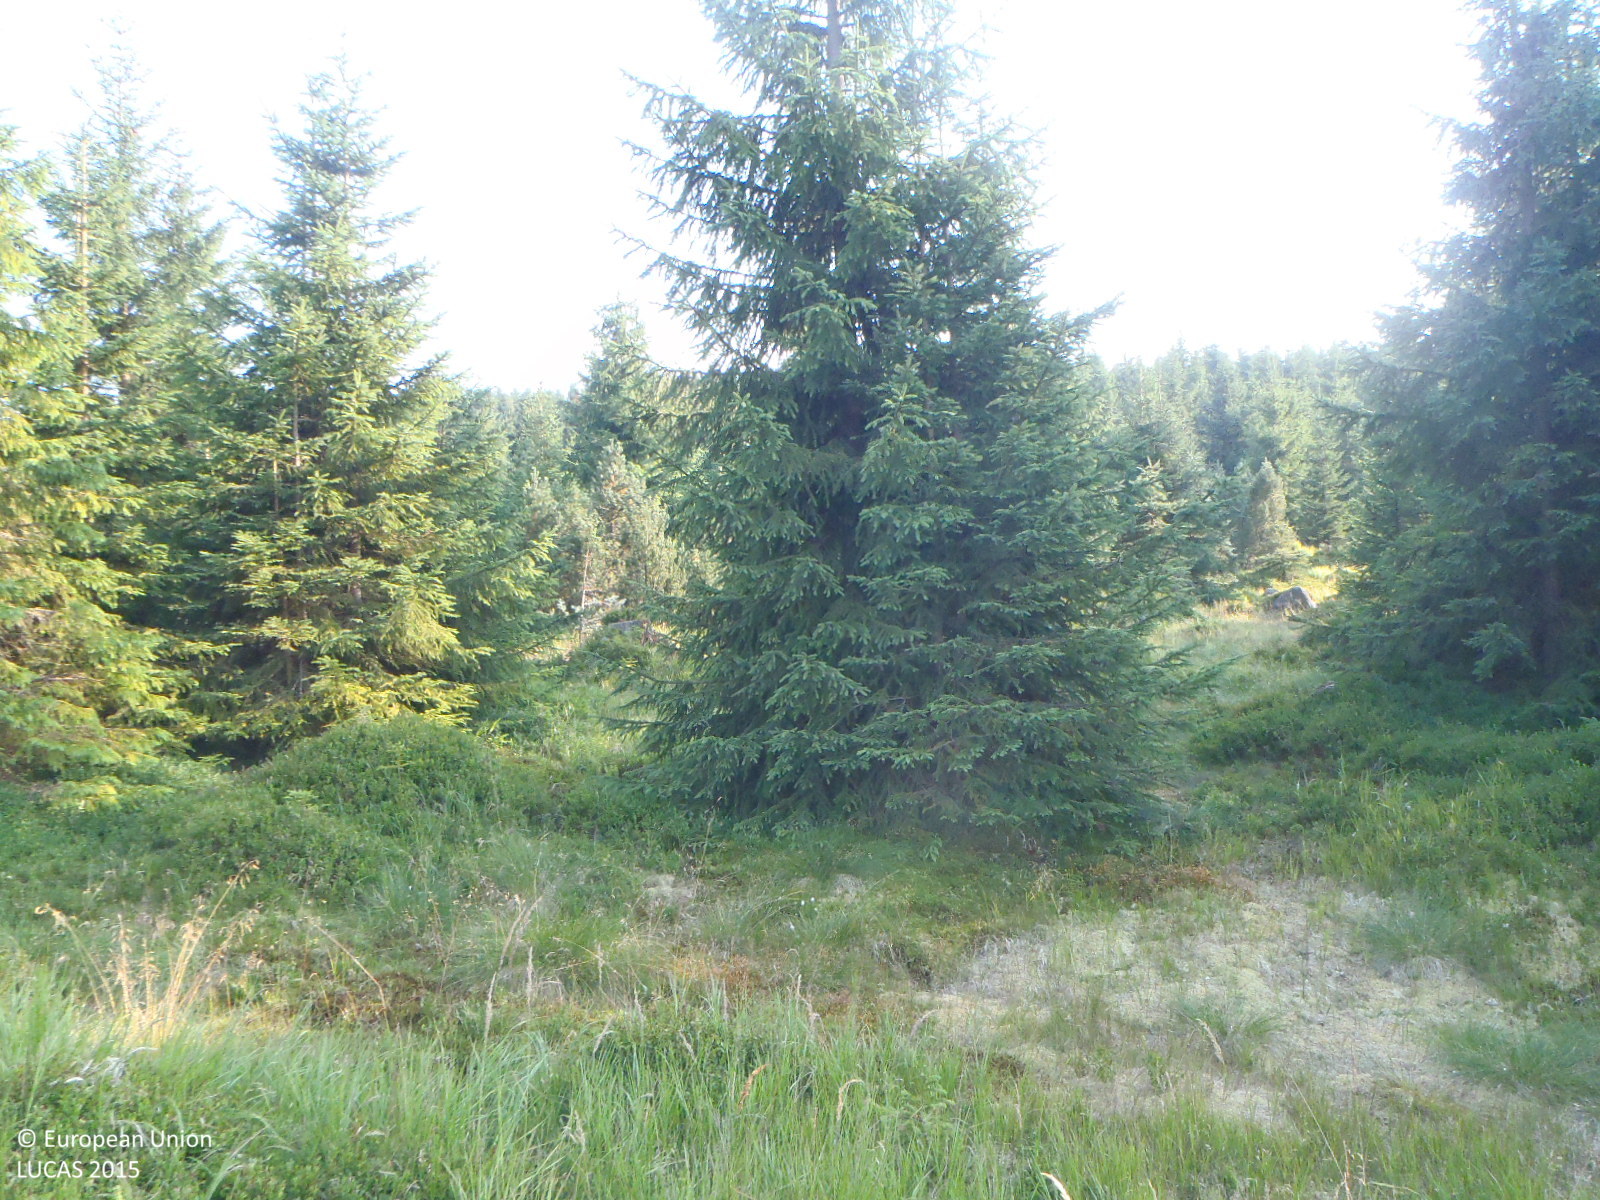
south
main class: Woodland
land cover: Spruce dominated coniferous woodland
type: mire and swamp forests
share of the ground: 25 - 50 %
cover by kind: coniferous forest trees 40 %, herbaceous plants 30 %, lichens and mosses 20 %, shrubs 10 %
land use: Semi-natural and natural areas not in use
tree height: > 5 m
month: August
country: CZ
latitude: 50.8525
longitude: 15.3305
